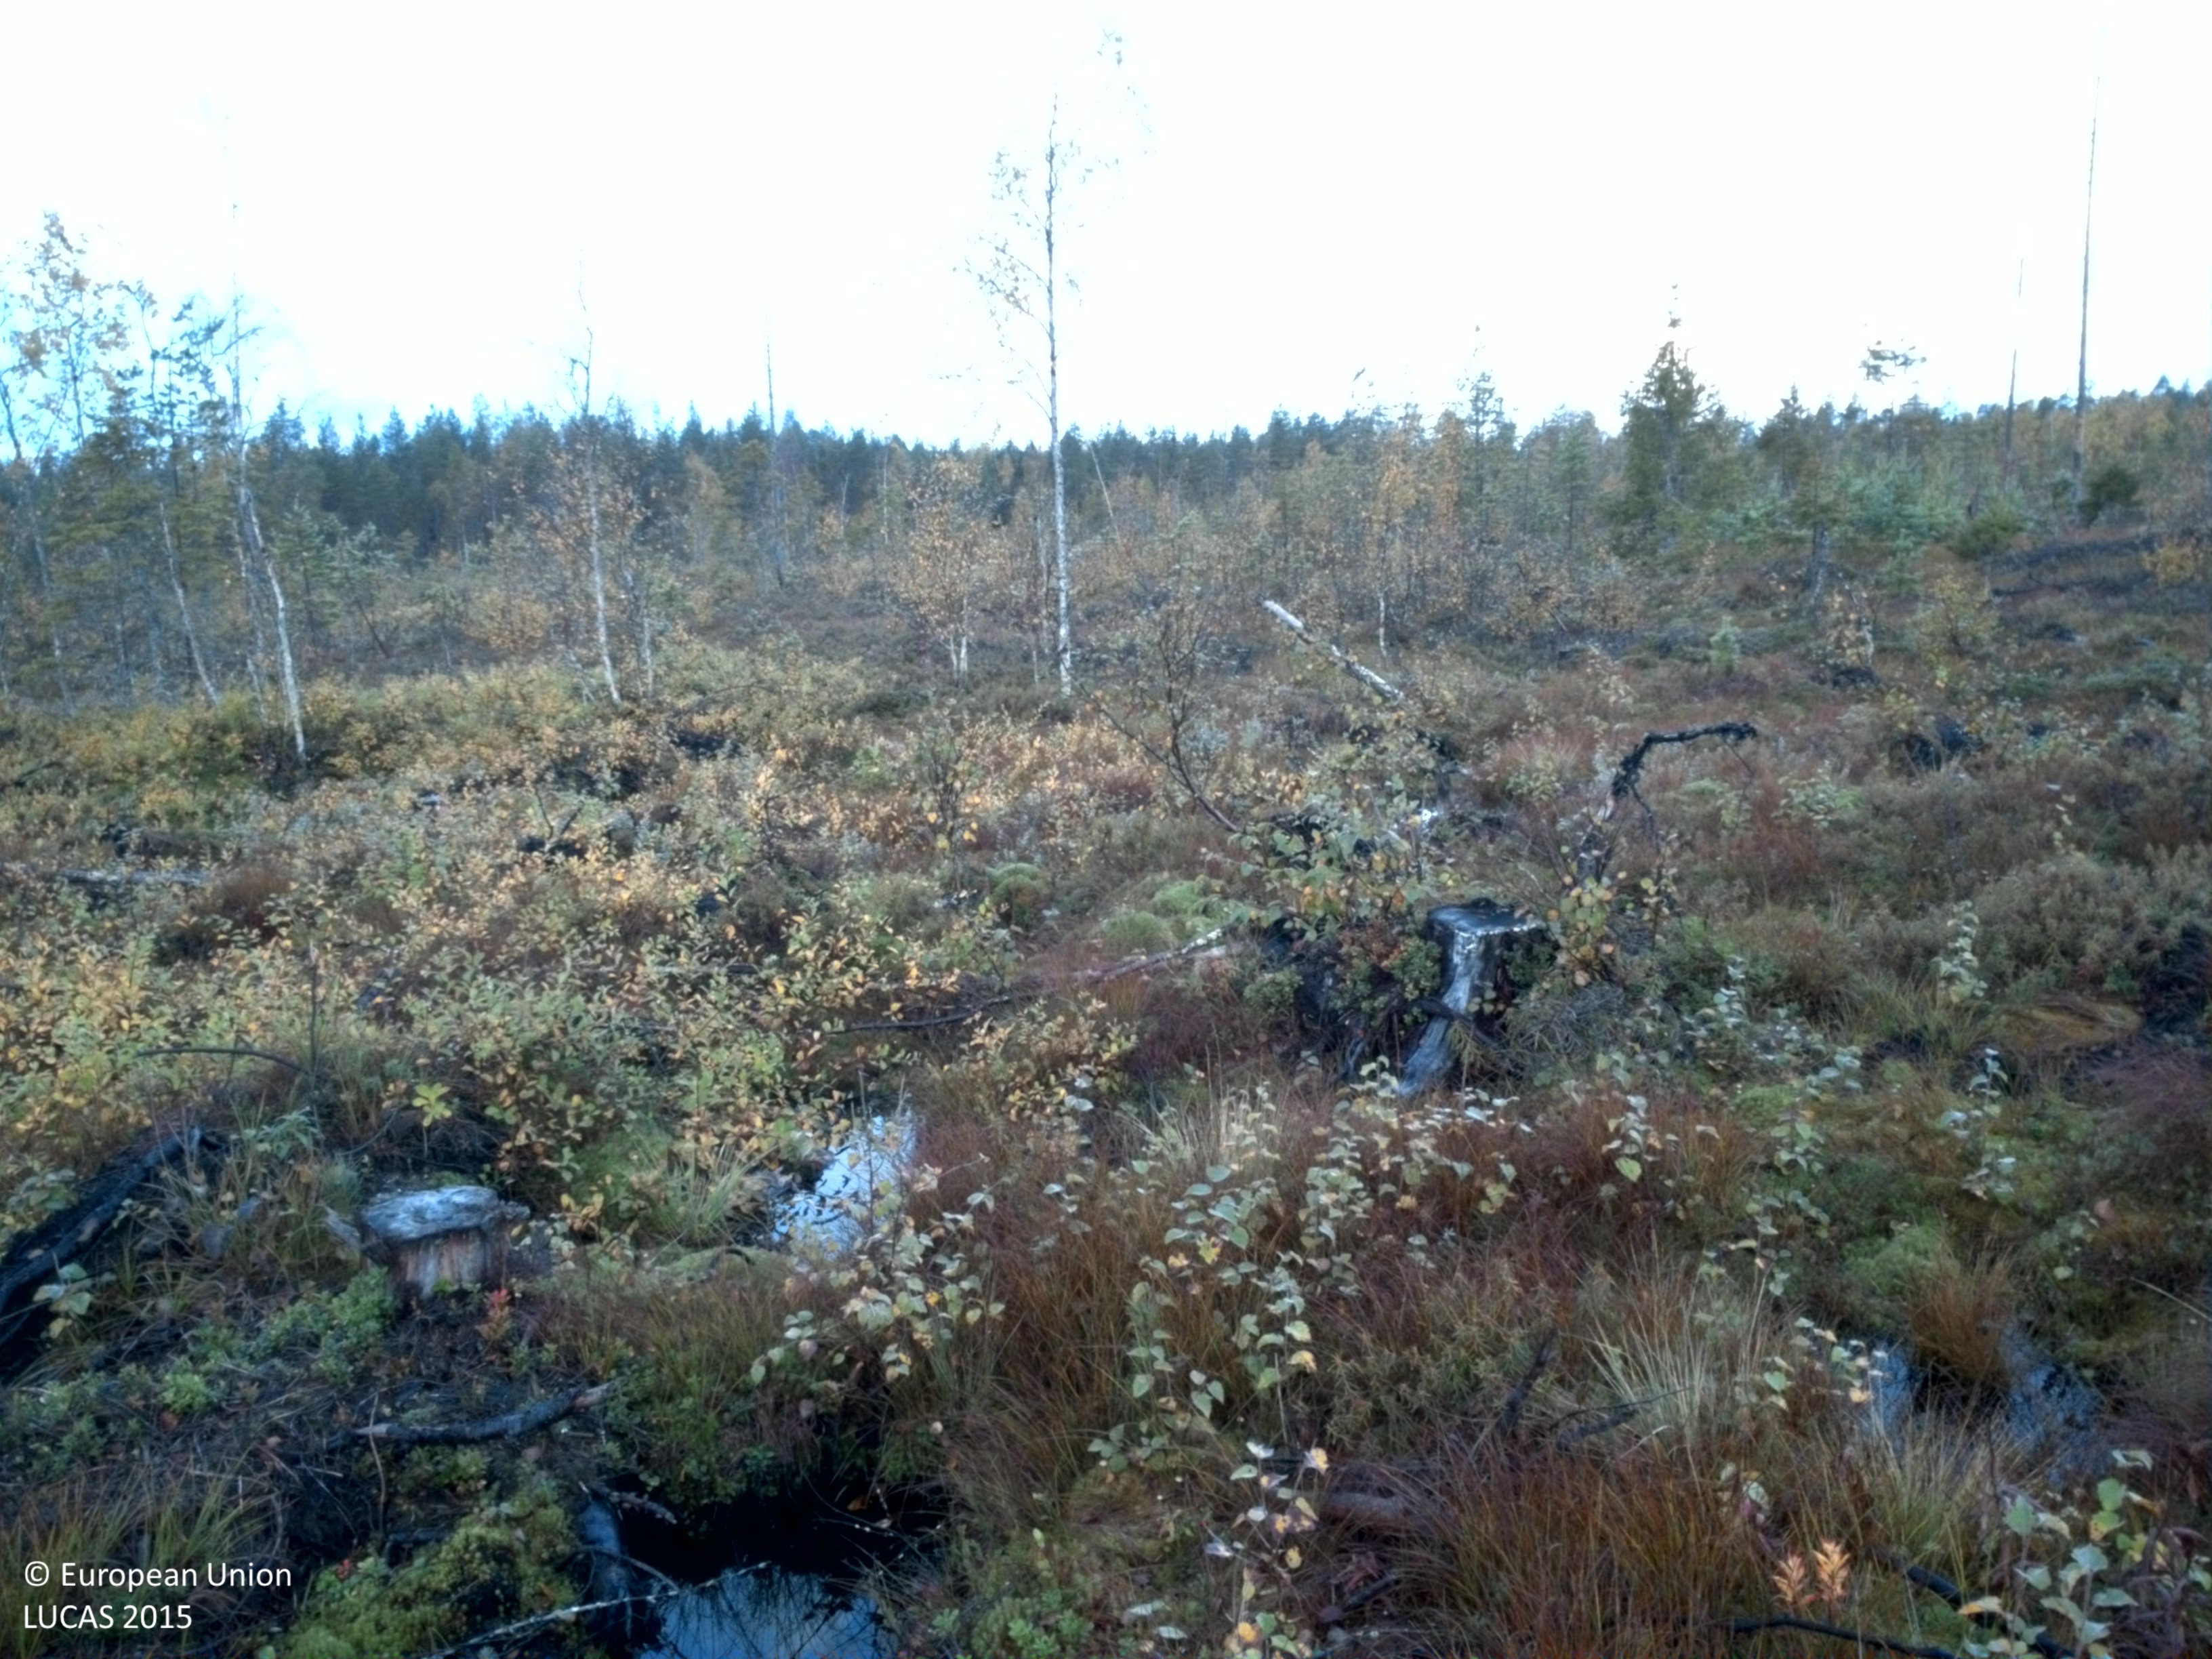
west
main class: Shrubland
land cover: Shrubland with sparse tree cover
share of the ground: 25 - 50 %
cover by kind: herbaceous plants 45 %, shrubs 40 %, lichens and mosses 10 %, broadleaved forest trees 5 %
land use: Forestry
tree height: < 5 m
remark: Clear cut
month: September
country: SE
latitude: 65.5807
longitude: 21.8782
